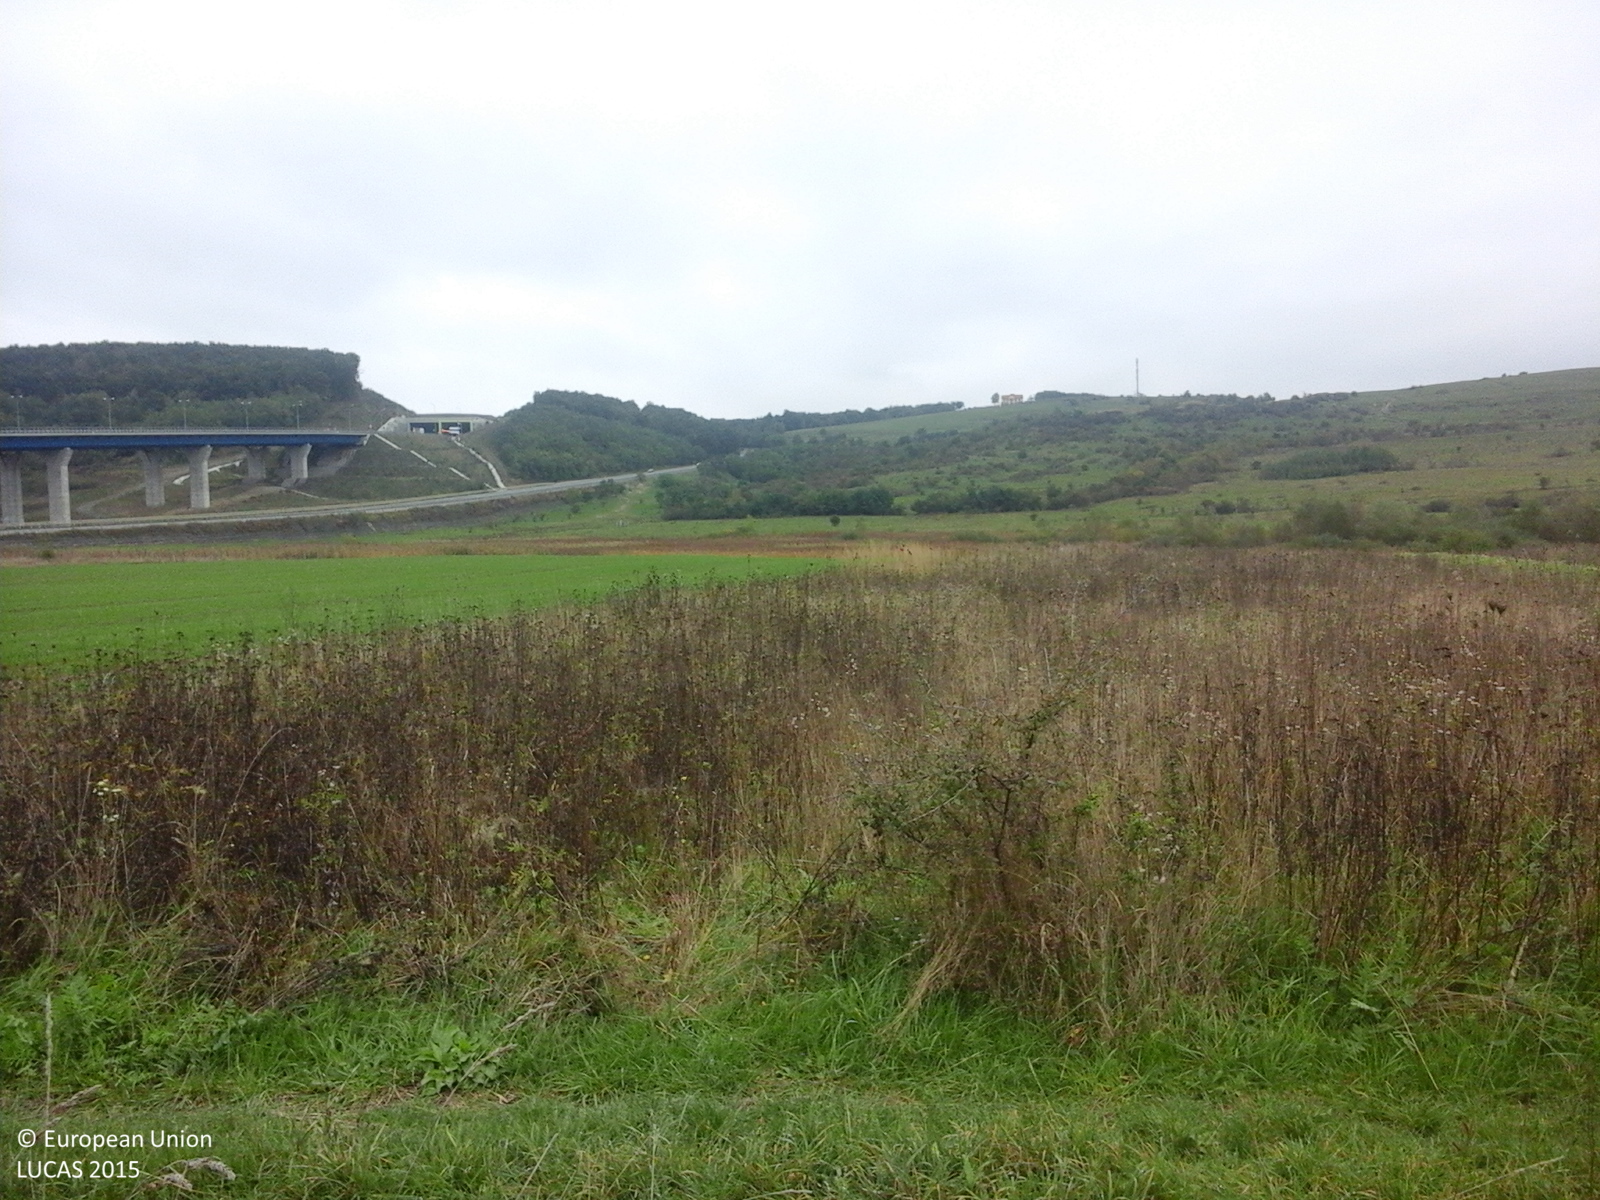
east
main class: Grassland
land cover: Spontaneously vegetated surfaces
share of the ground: > 75 %
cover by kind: herbaceous plants 100 %
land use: Fallow land
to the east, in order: Spontaneously vegetated surfaces; Grass margins; Tracks; Grass margins; Spontaneously vegetated surfaces; Common wheat; Inland marshes; Rivers and streams; Inland marshes
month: October
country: RO
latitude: 45.7790
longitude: 23.9483
